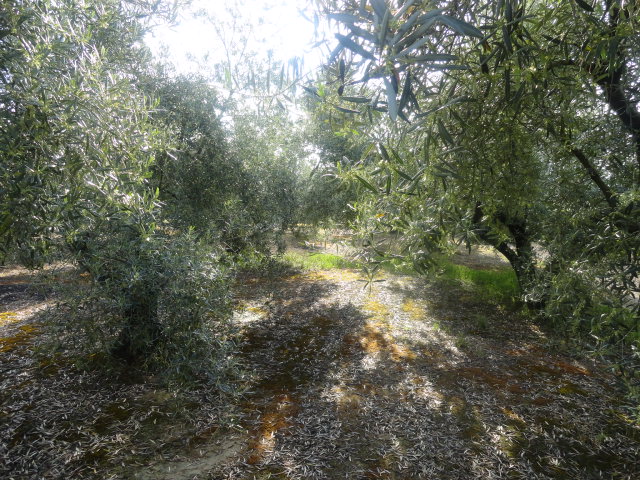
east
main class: Cropland
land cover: Olive groves
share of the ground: > 75 %
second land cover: Spontaneously vegetated surfaces
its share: 10 - 25 %
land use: Agriculture (excluding fallow land and kitchen gardens)
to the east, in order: Olive groves; Spontaneously vegetated surfaces; Other structural elements; Olive groves
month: April
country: ES
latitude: 37.5881
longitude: -4.6048
